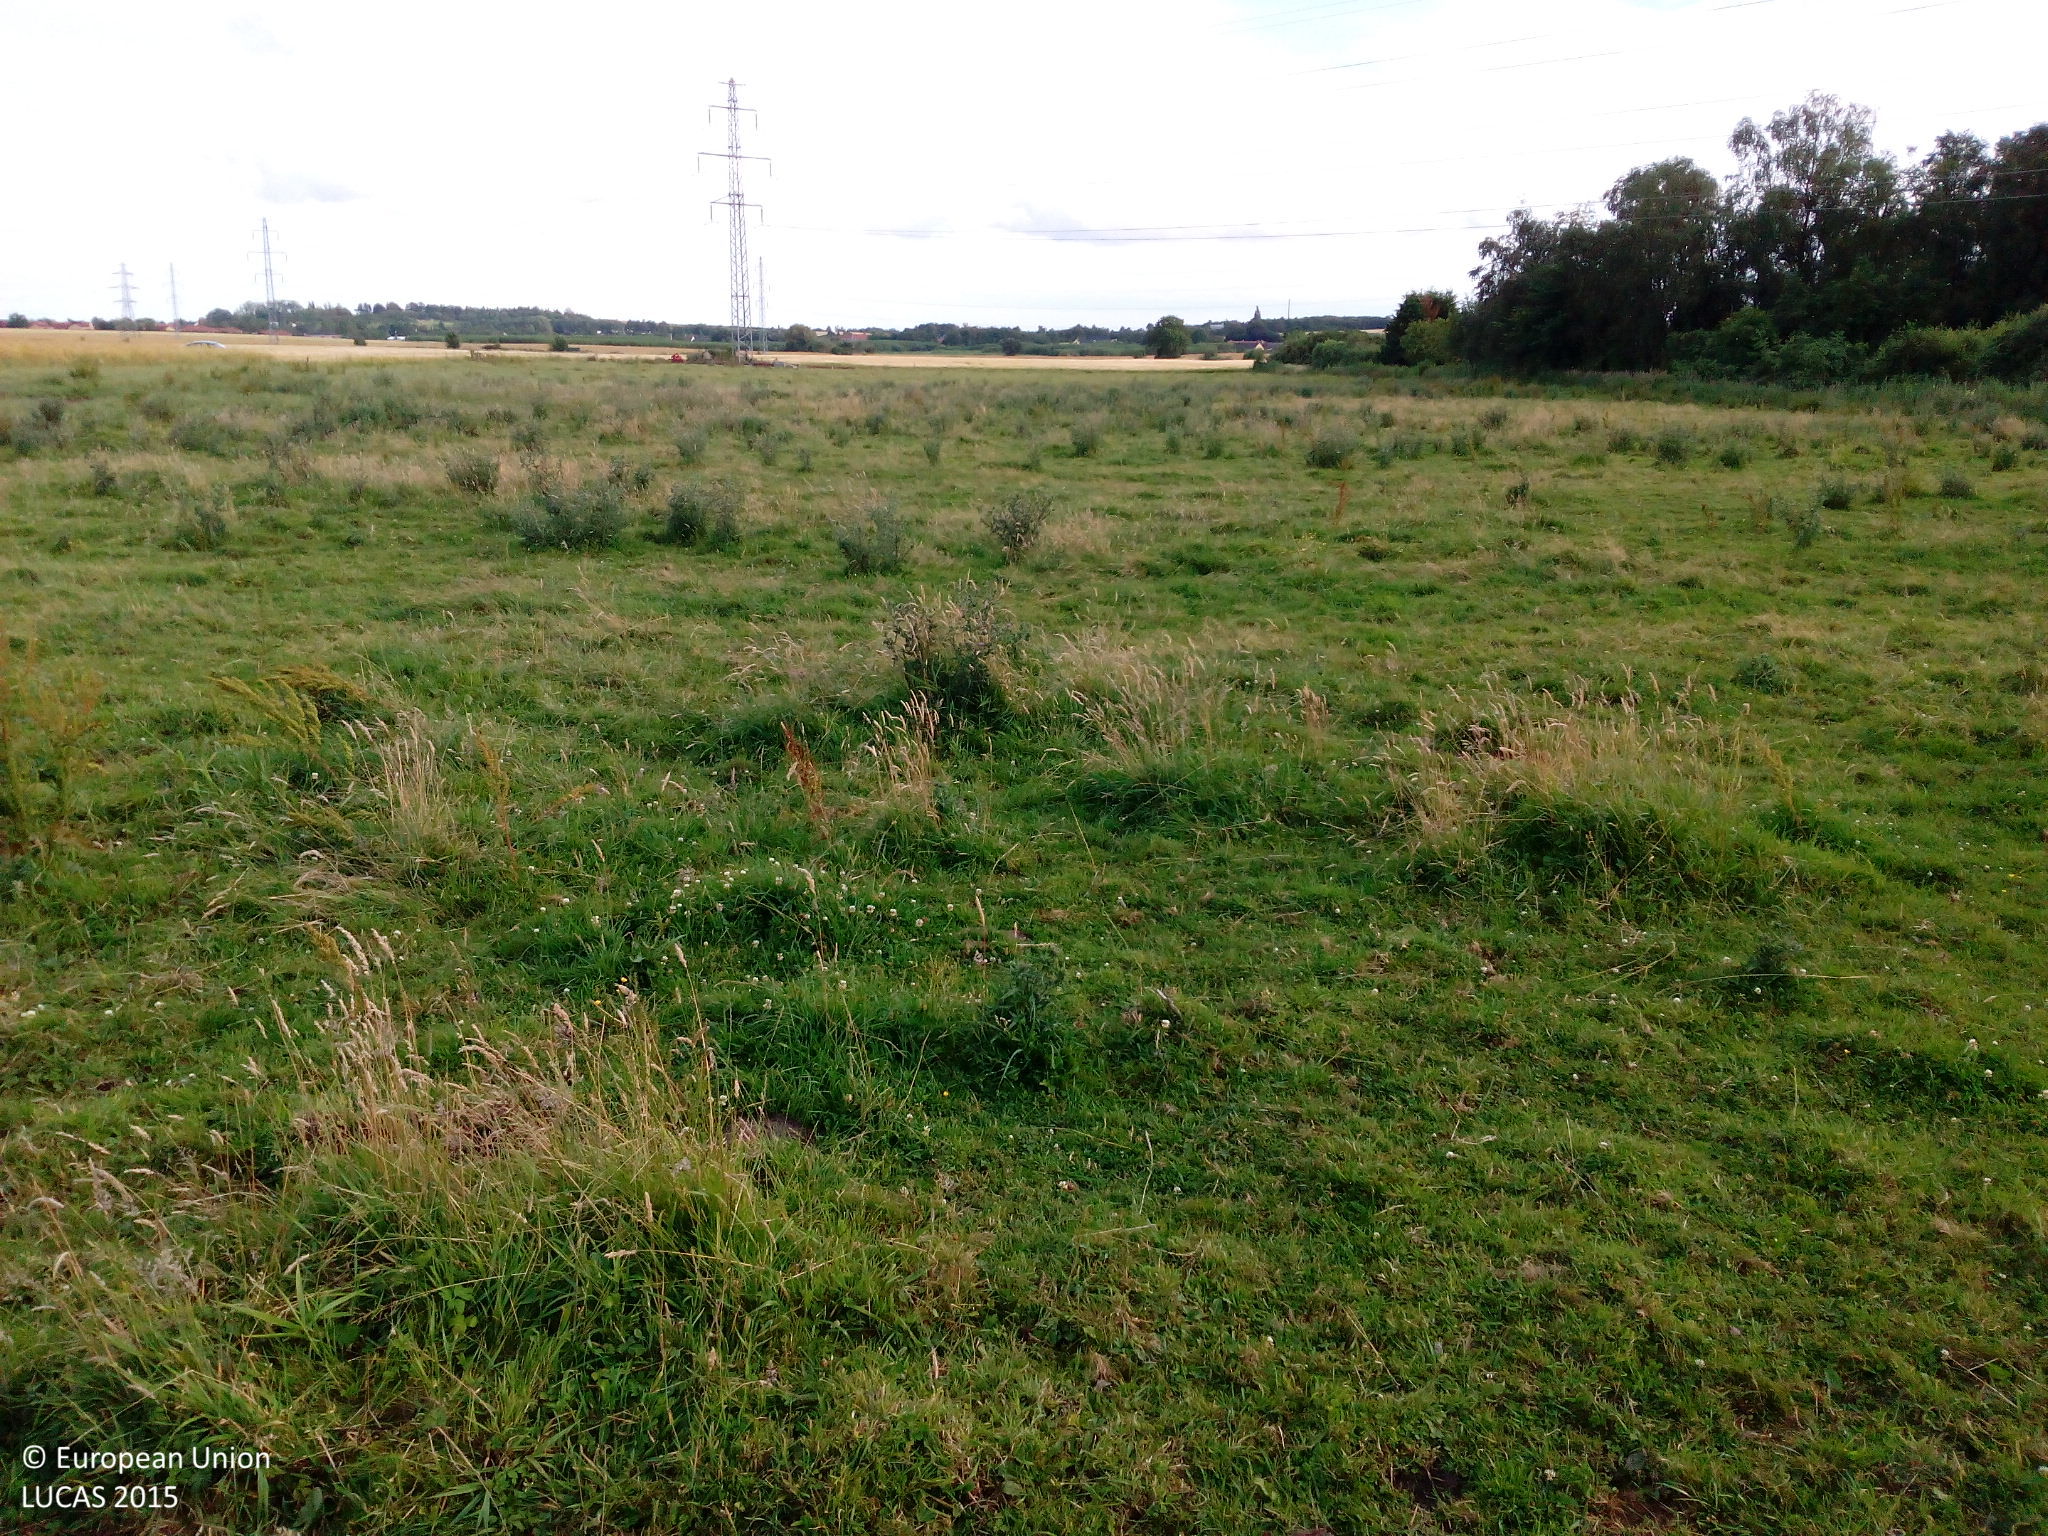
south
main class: Cropland
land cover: Rape and turnip rape
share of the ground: > 75 %
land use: Agriculture (excluding fallow land and kitchen gardens)
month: July
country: DK
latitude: 55.9374
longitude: 12.0632
